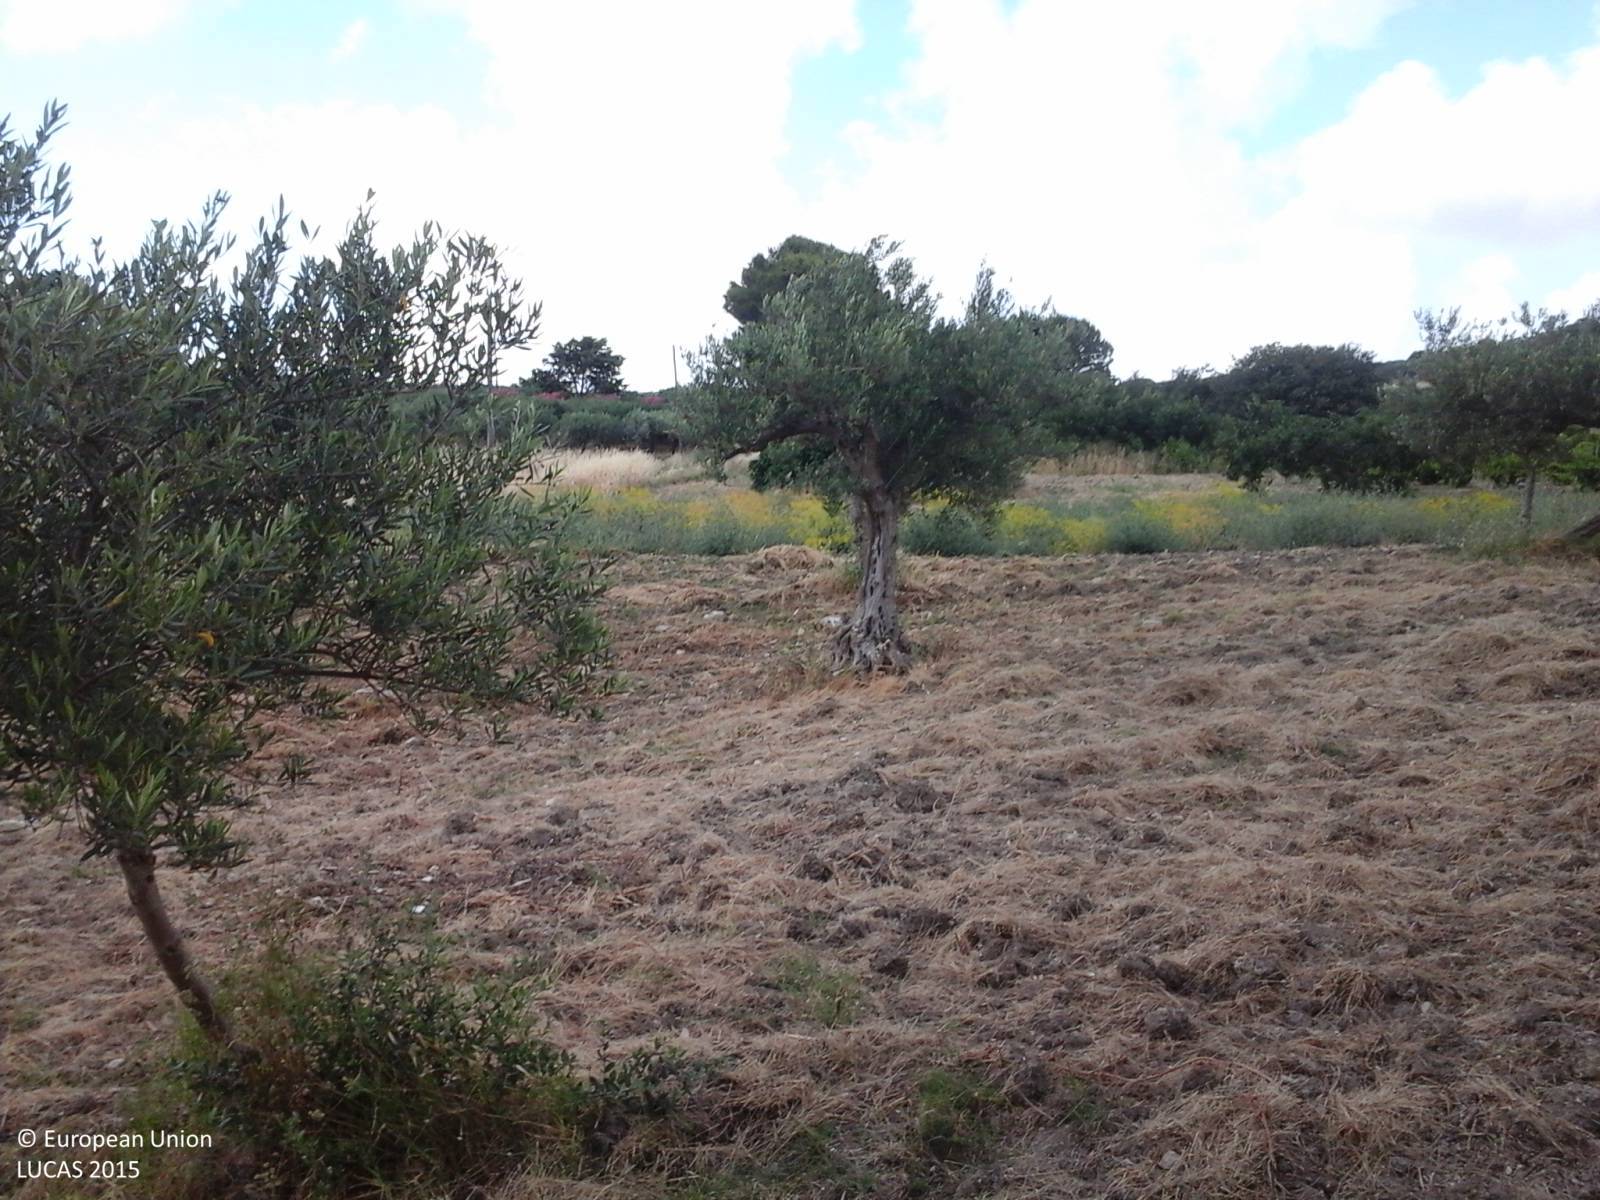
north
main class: Cropland
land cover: Olive groves
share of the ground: 25 - 50 %
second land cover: Other bare soil
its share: > 75 %
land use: Agriculture (excluding fallow land and kitchen gardens)
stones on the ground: < 10 %
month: June
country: IT
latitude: 38.0191
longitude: 12.6577
